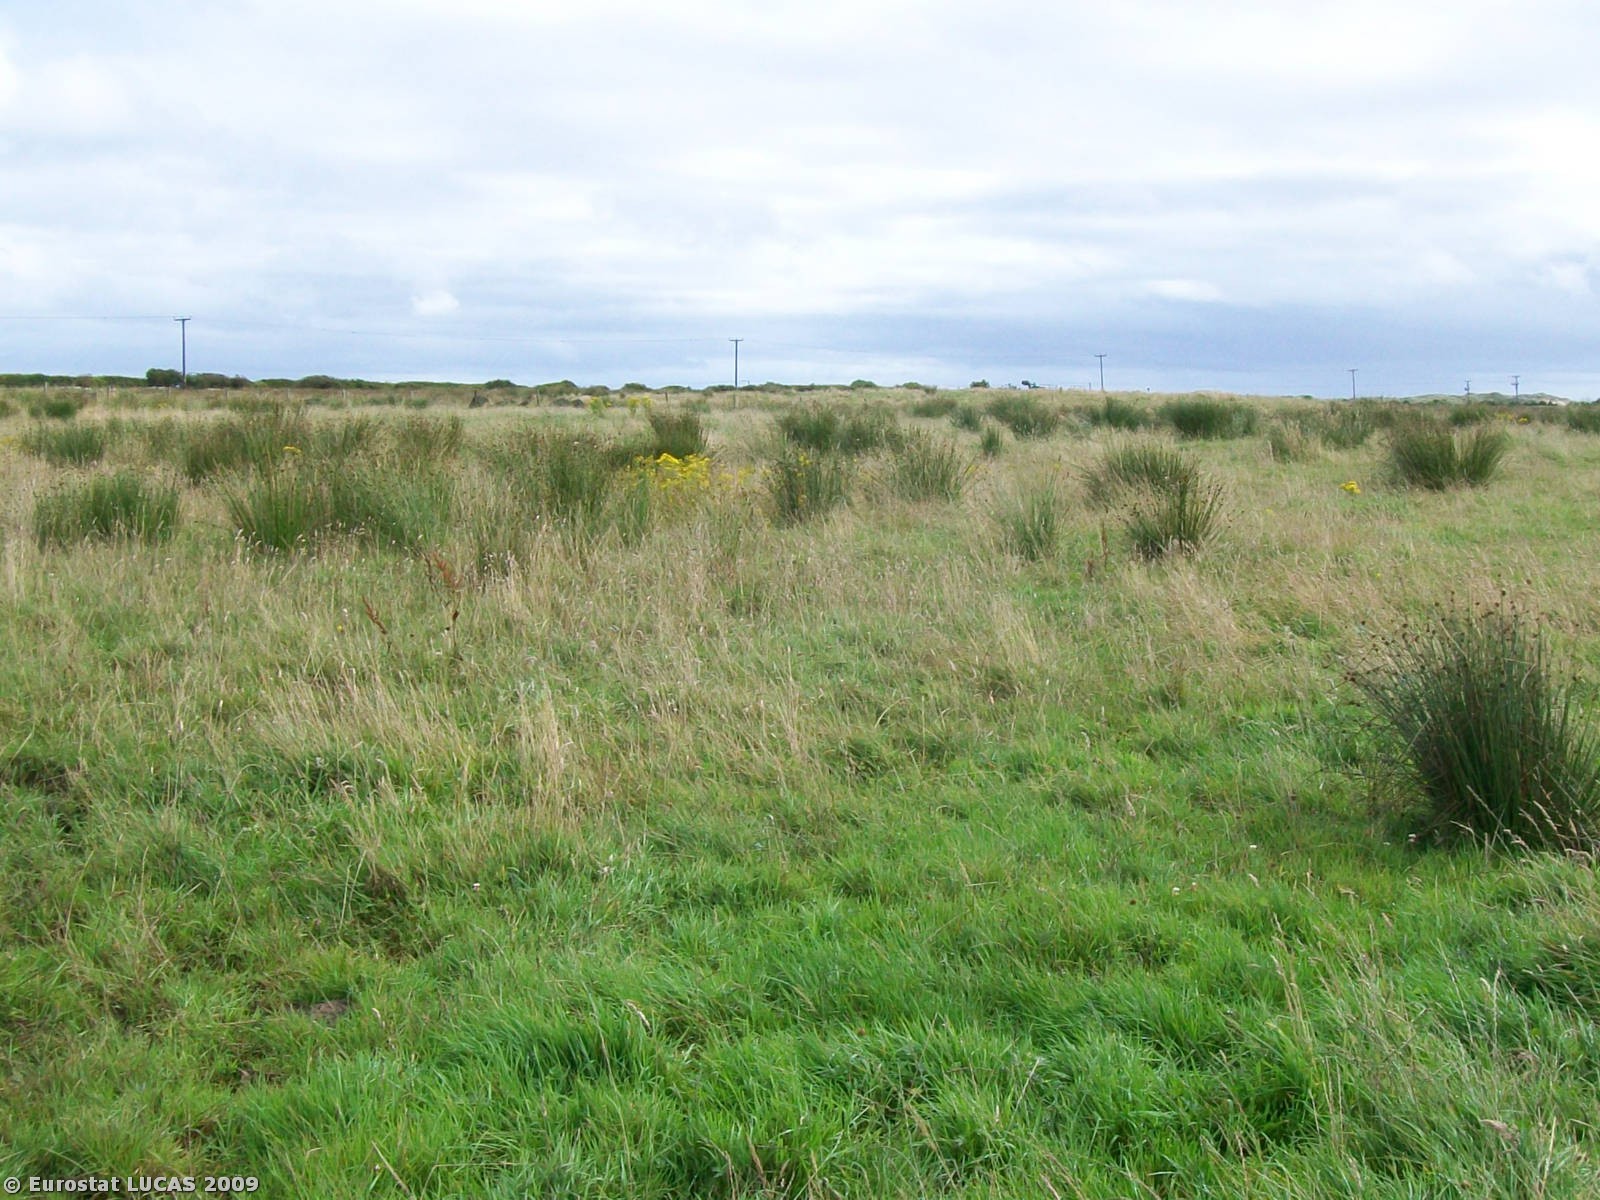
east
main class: Grassland
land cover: Grassland without tree/shrub cover
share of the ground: > 75 %
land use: Agriculture (excluding fallow land and kitchen gardens)
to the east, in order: Grassland without tree/shrub cover; Fences; Grassland without tree/shrub cover; Electric lines; Fences; Abandoned hedges; Ditches and canals; Grass margins; Paved roads, cycling and walking lanes; Grass margins; Ditches and canals; Abandoned hedges; Fences; Grassland without tree/shrub cover
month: August
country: GB
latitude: 58.5188
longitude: -3.1577
